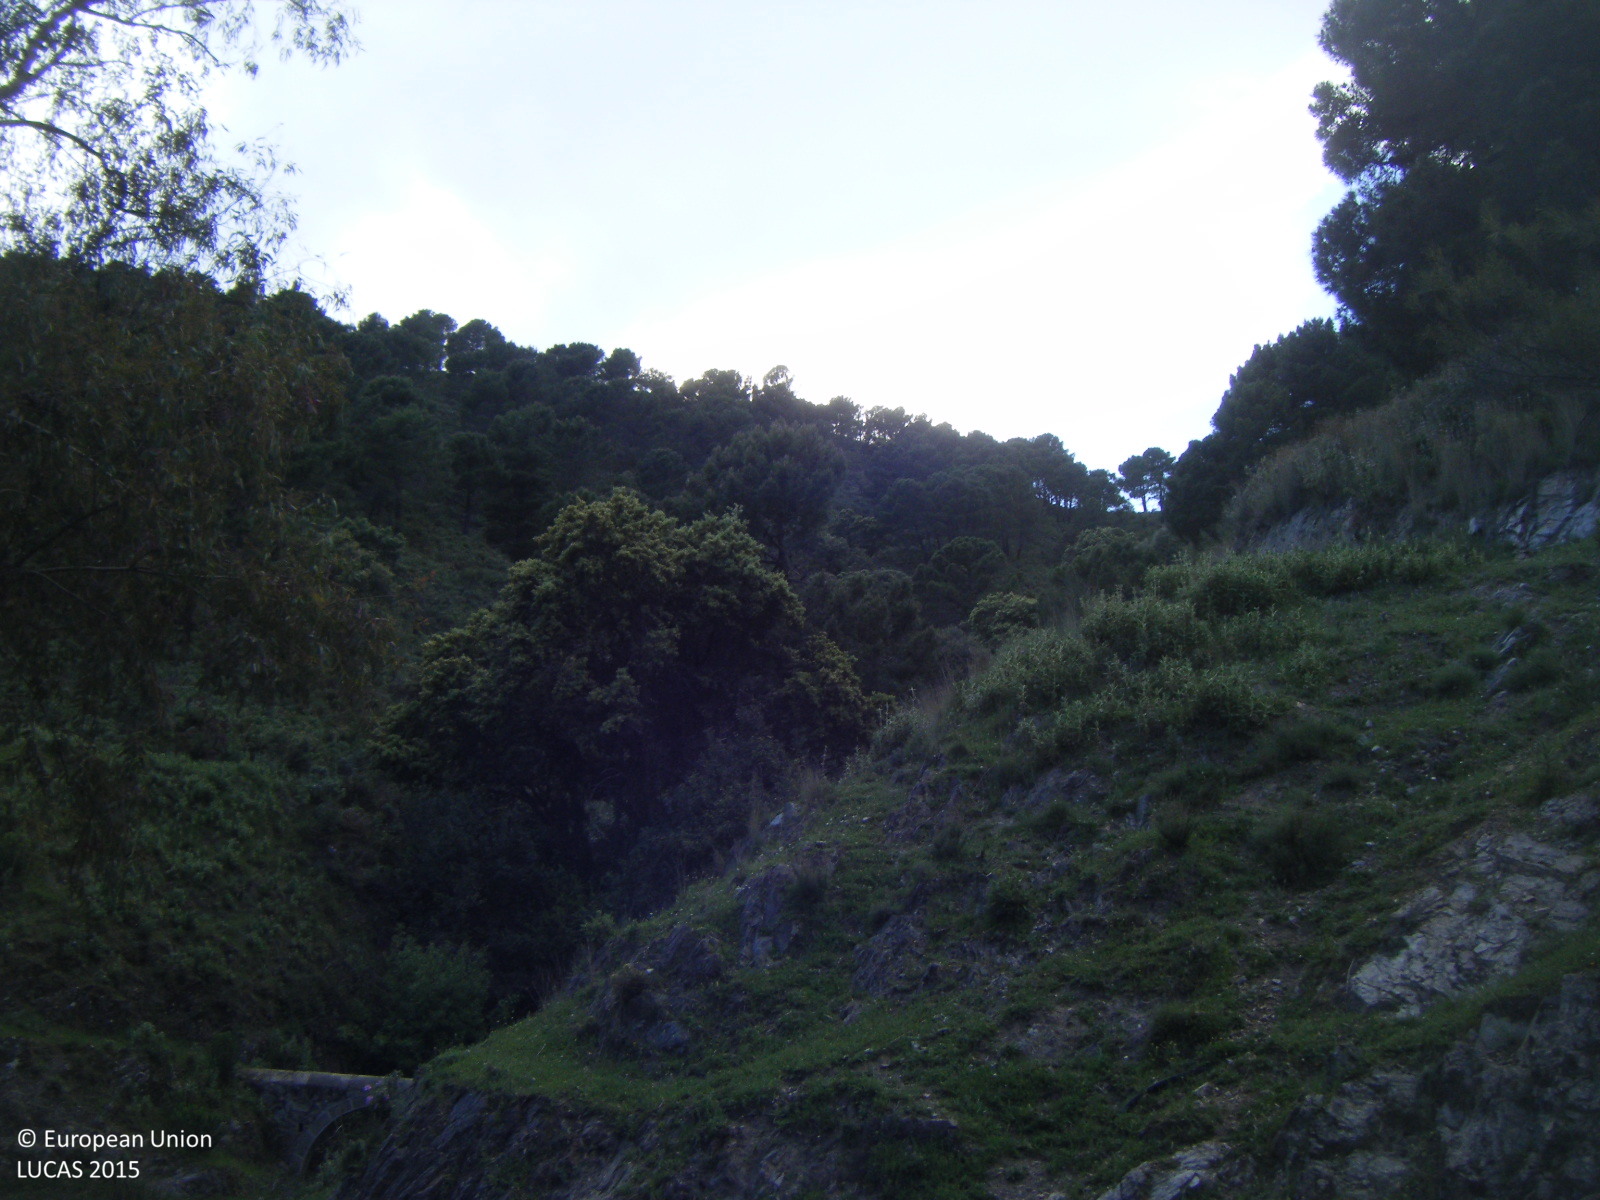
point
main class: Woodland
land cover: Pine dominated coniferous woodland
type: coniferous forest of the mediterranean region
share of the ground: 25 - 50 %
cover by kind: coniferous forest trees 40 %, shrubs 40 %, herbaceous plants 20 %
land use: Forestry
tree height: > 5 m
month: April
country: ES
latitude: 36.8685
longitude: -4.0216
